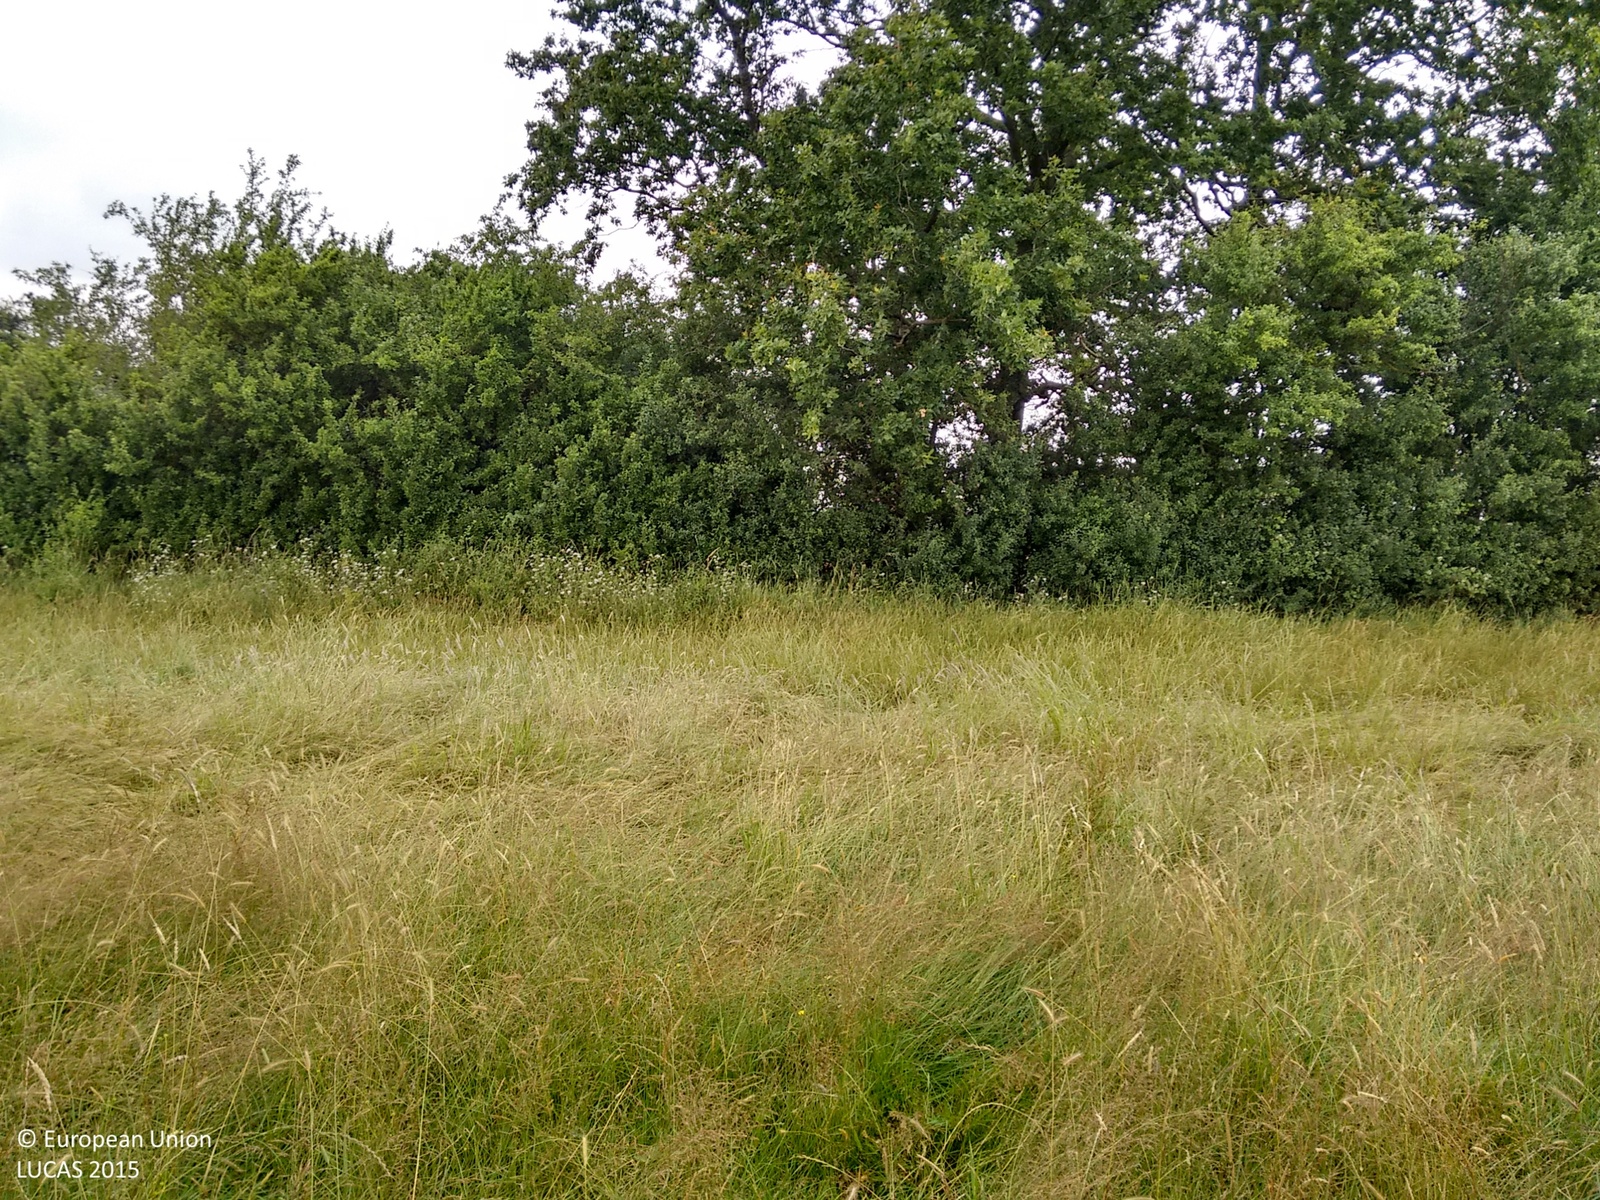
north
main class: Grassland
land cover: Grassland without tree/shrub cover
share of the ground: > 75 %
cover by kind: herbaceous plants 100 %
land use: Agriculture (excluding fallow land and kitchen gardens)
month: July
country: GB
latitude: 51.8297
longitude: -1.1764
